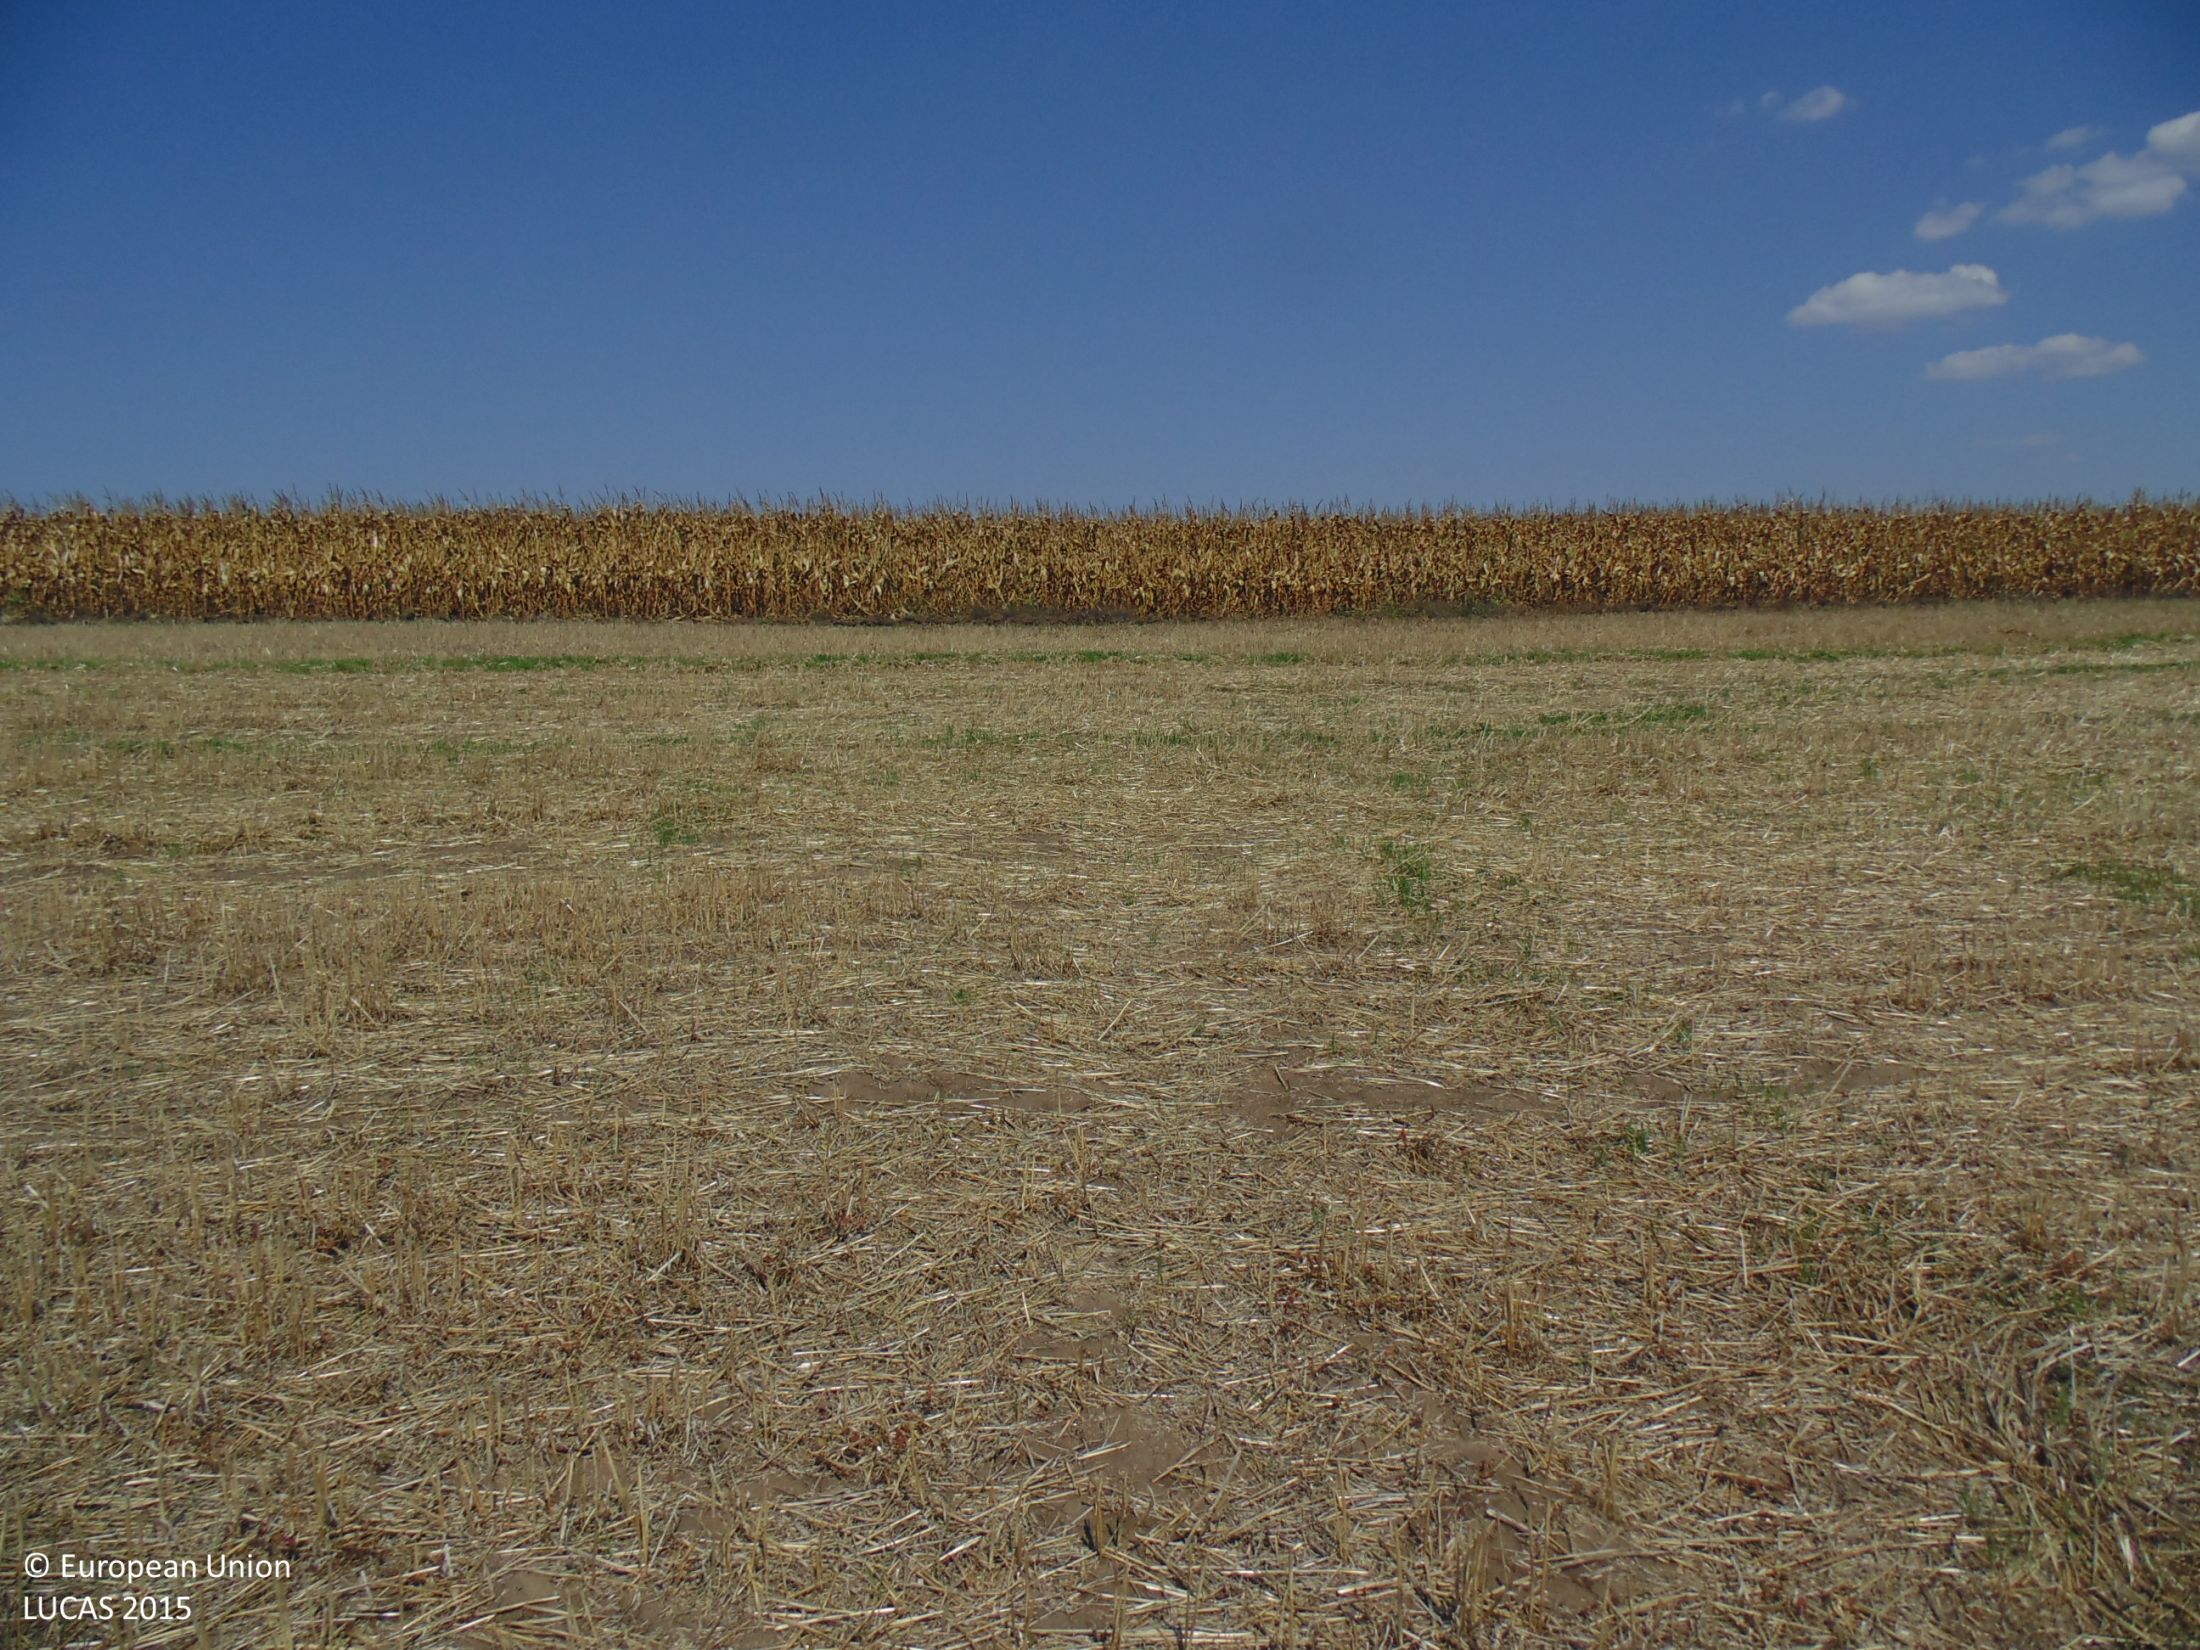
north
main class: Cropland
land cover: Common wheat
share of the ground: 25 - 50 %
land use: Agriculture (excluding fallow land and kitchen gardens)
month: August
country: BG
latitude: 43.6672
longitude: 27.4572
